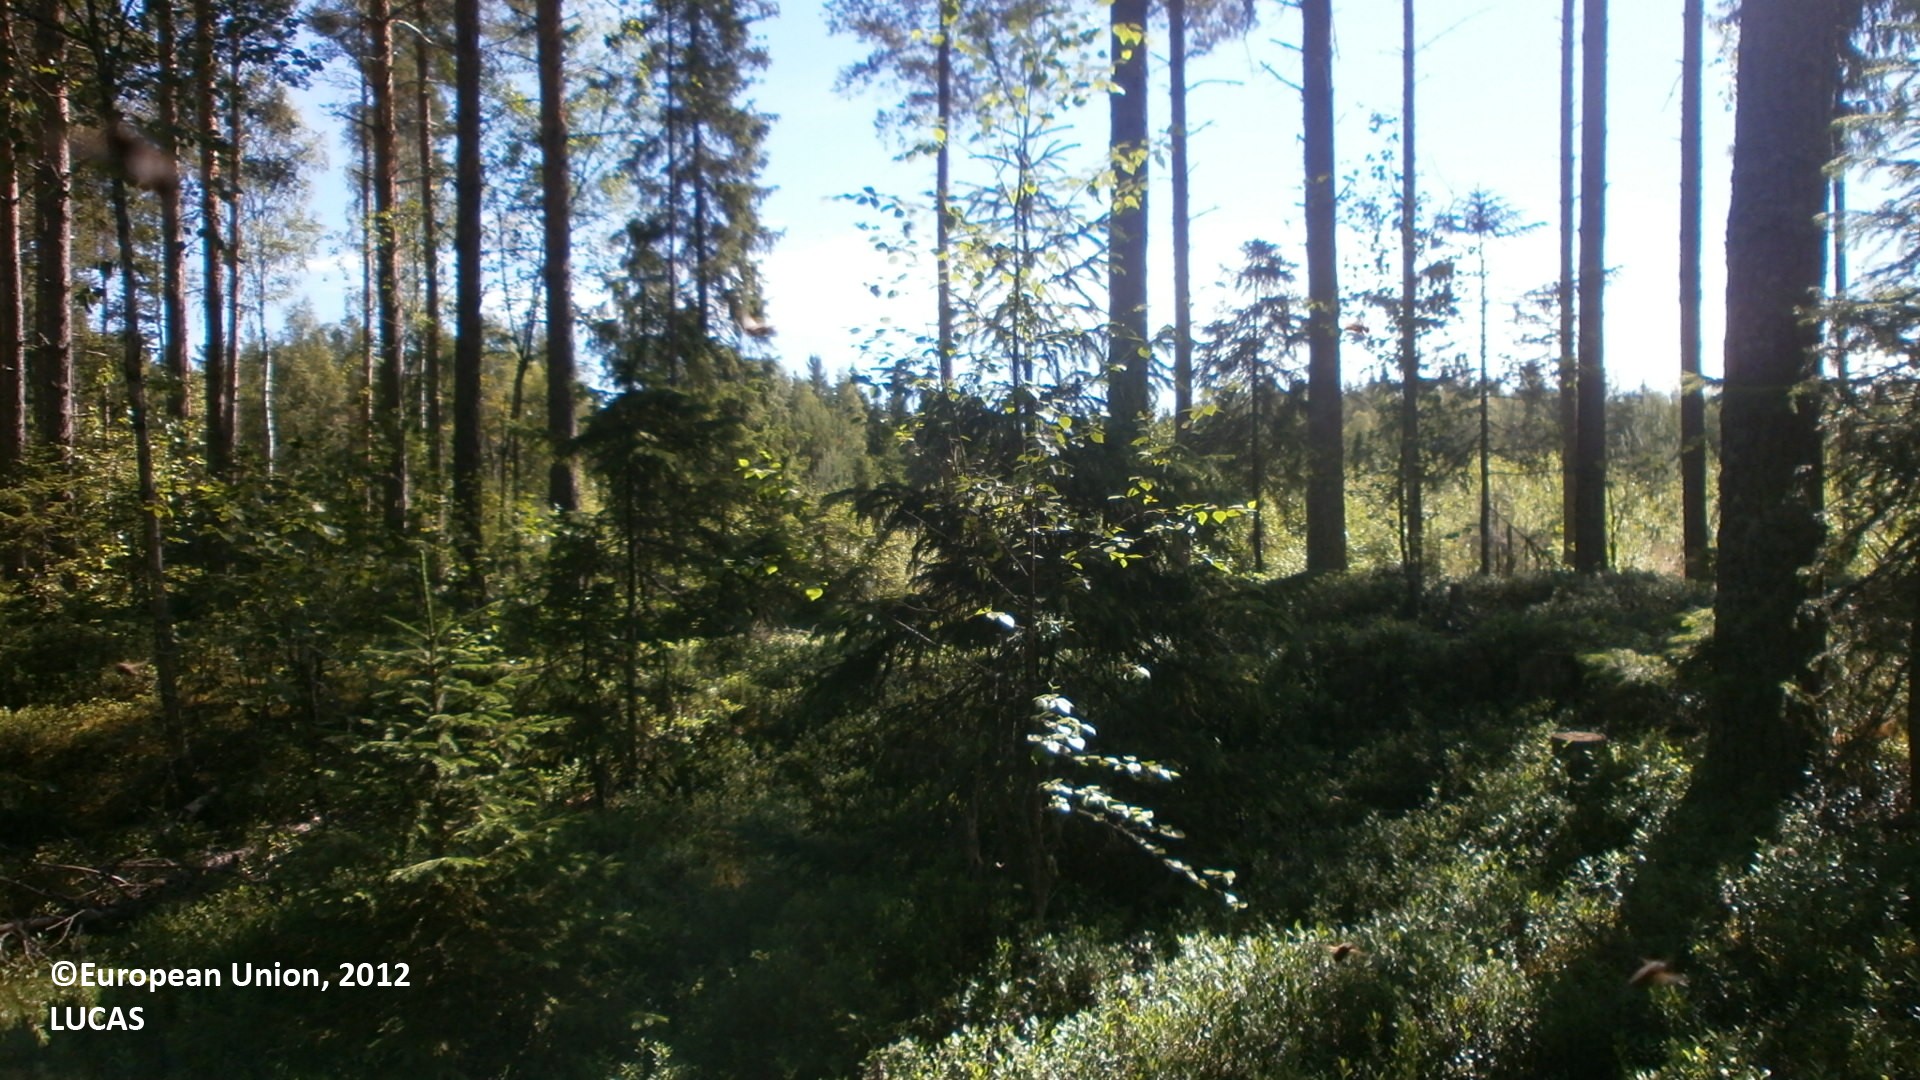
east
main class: Woodland
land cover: Pine dominated mixed woodland
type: boreal forest
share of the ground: 50 - 75 %
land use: Forestry
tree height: > 5 m
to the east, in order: Pine dominated mixed woodland; Pine dominated coniferous woodland; Pine dominated mixed woodland; Broadleaved woodland; Ditches and canals; Pine dominated mixed woodland; Ditches and canals; Broadleaved woodland; Tracks; Ditches and canals; Pine dominated mixed woodland; Spruce dominated mixed woodland; Ditches and canals; Spruce dominated mixed woodland; Pine dominated mixed woodland; Spontaneously vegetated surfaces; Broadleaved woodland
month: July
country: FI
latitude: 64.3727
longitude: 24.0920
